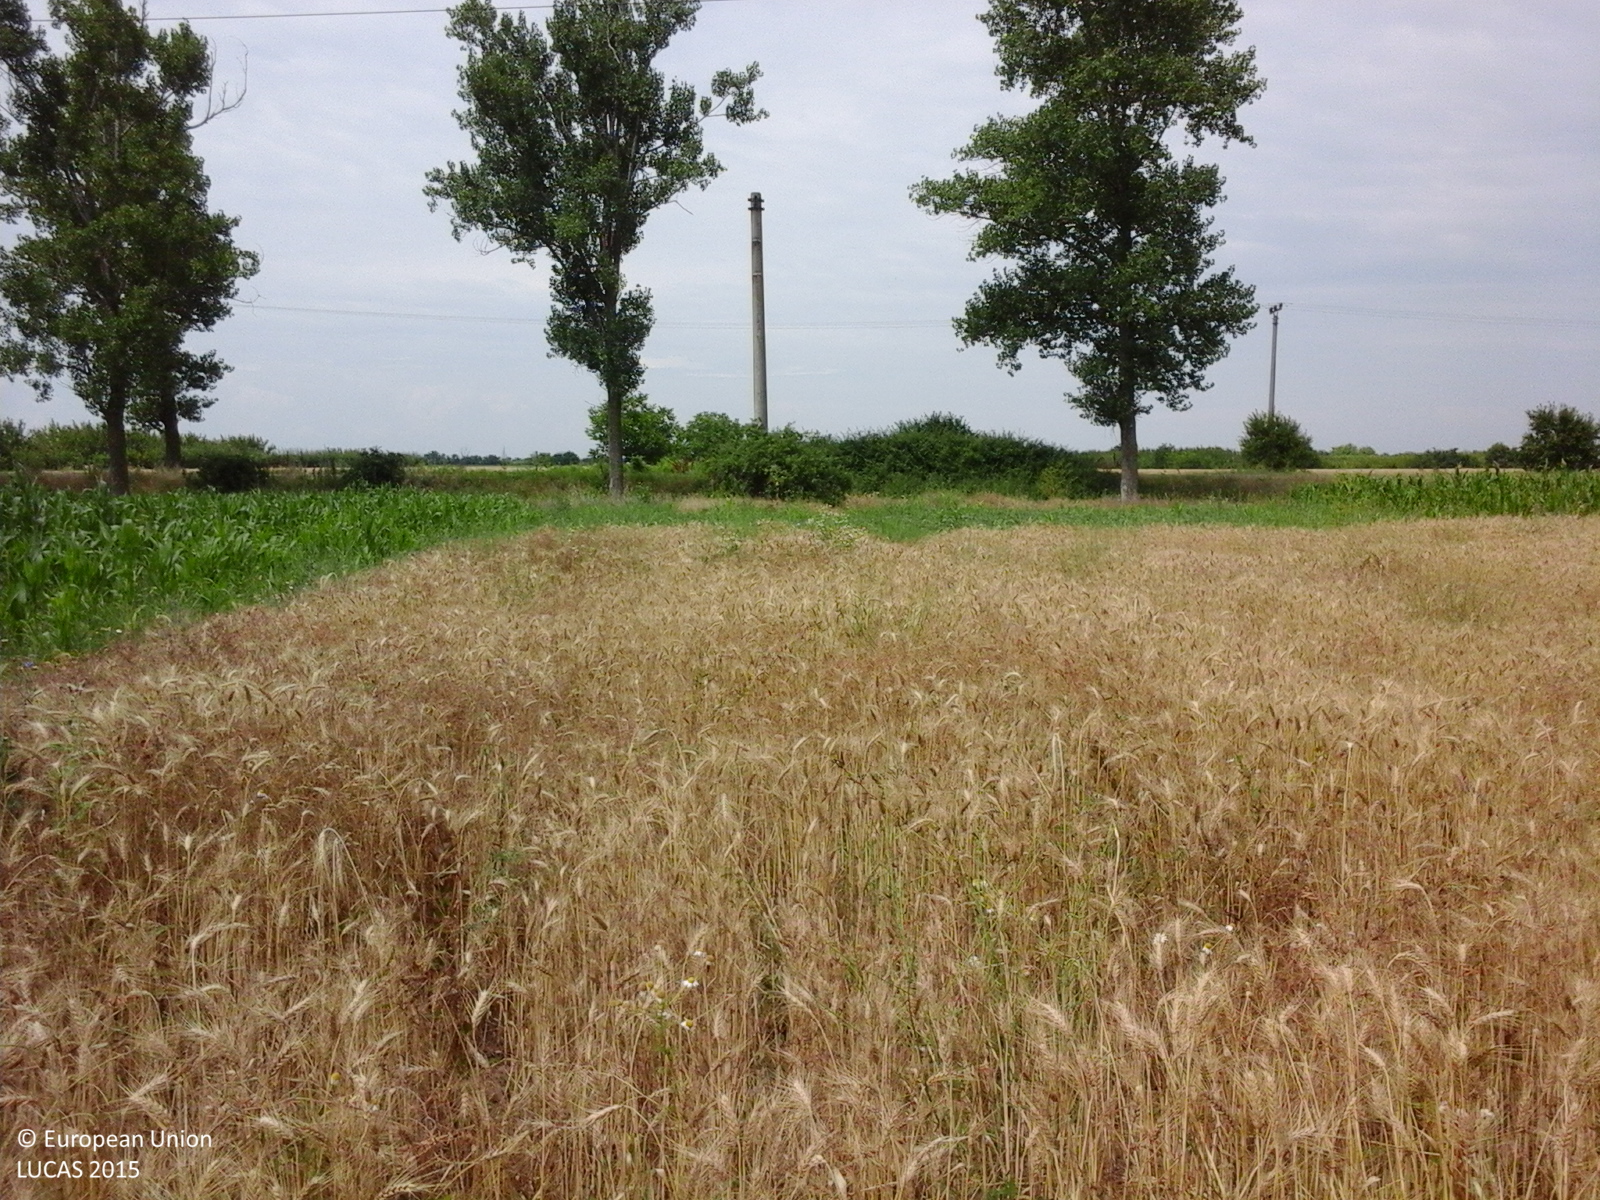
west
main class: Cropland
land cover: Common wheat
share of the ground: > 75 %
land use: Agriculture (excluding fallow land and kitchen gardens)
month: June
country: RO
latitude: 44.1595
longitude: 26.3772
